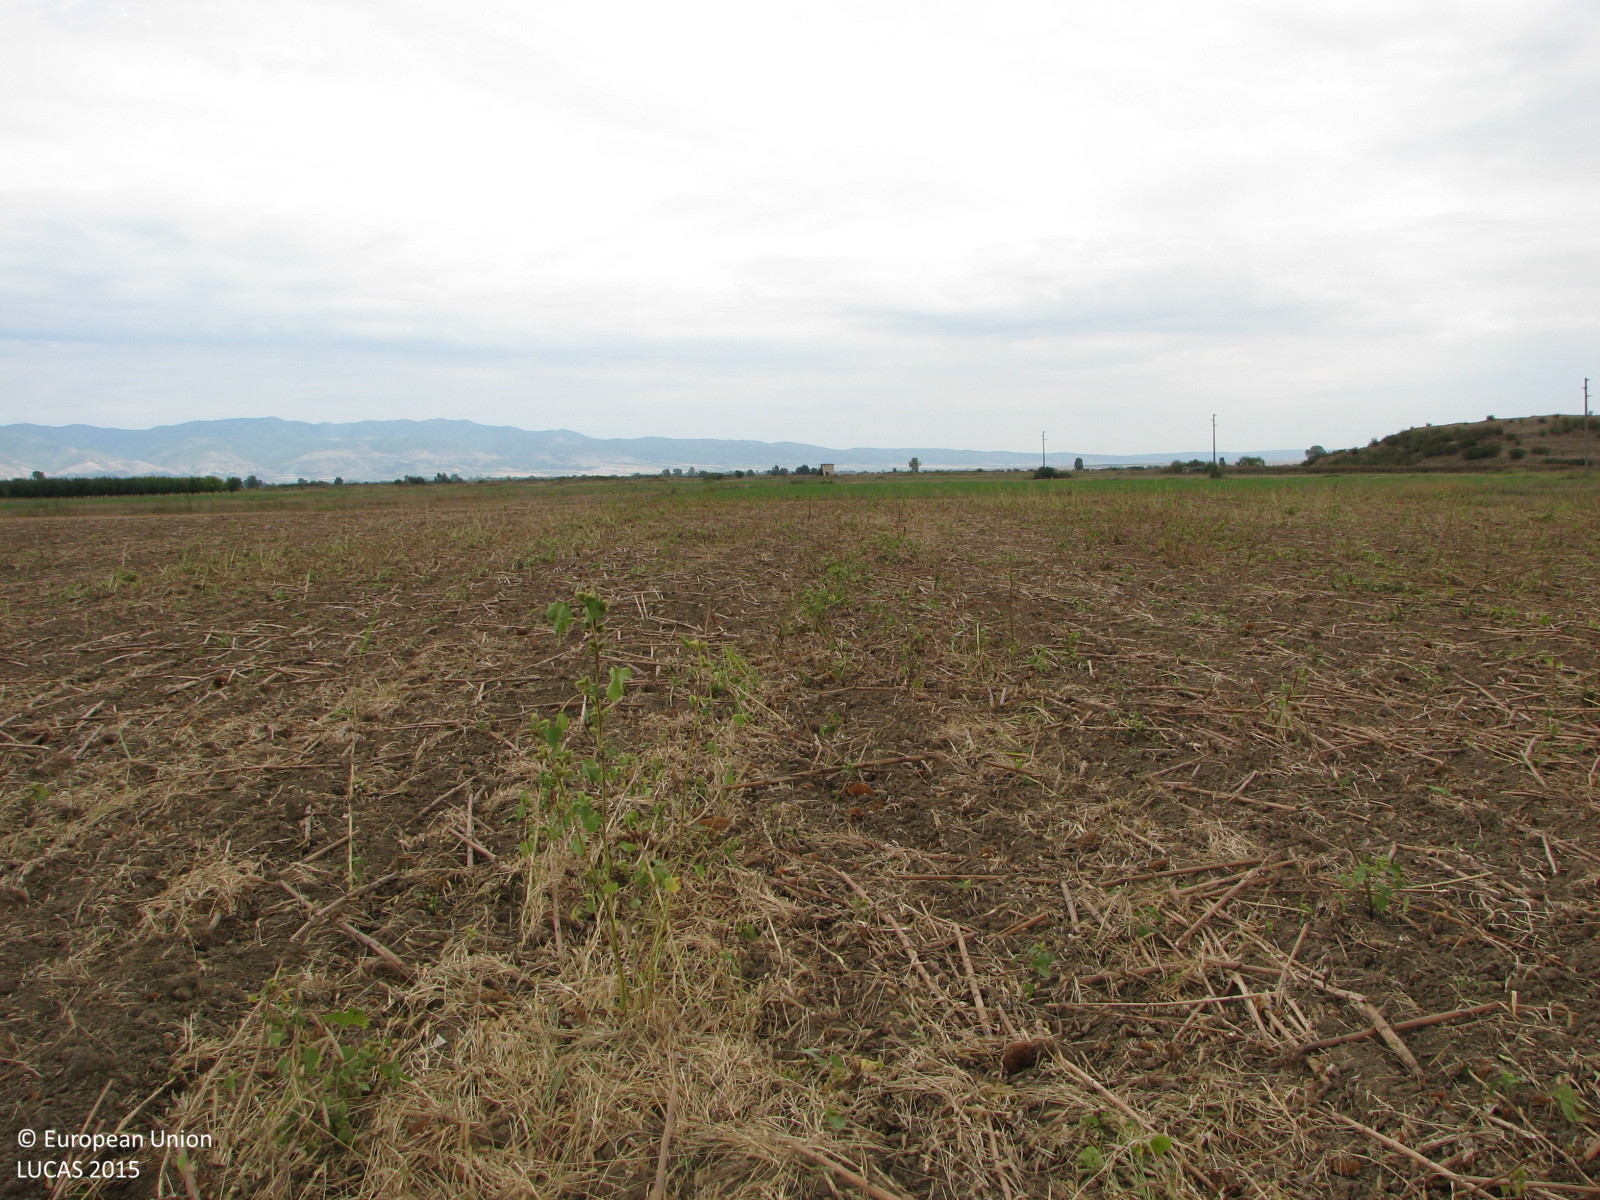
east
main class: Cropland
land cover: Sunflower
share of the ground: < 10 %
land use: Agriculture (excluding fallow land and kitchen gardens)
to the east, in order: Sunflower; Lucerne; Electric lines; Lucerne; Tracks; Grass margins; Other bare soil; Lucerne
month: September
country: BG
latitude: 42.5493
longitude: 26.4469
